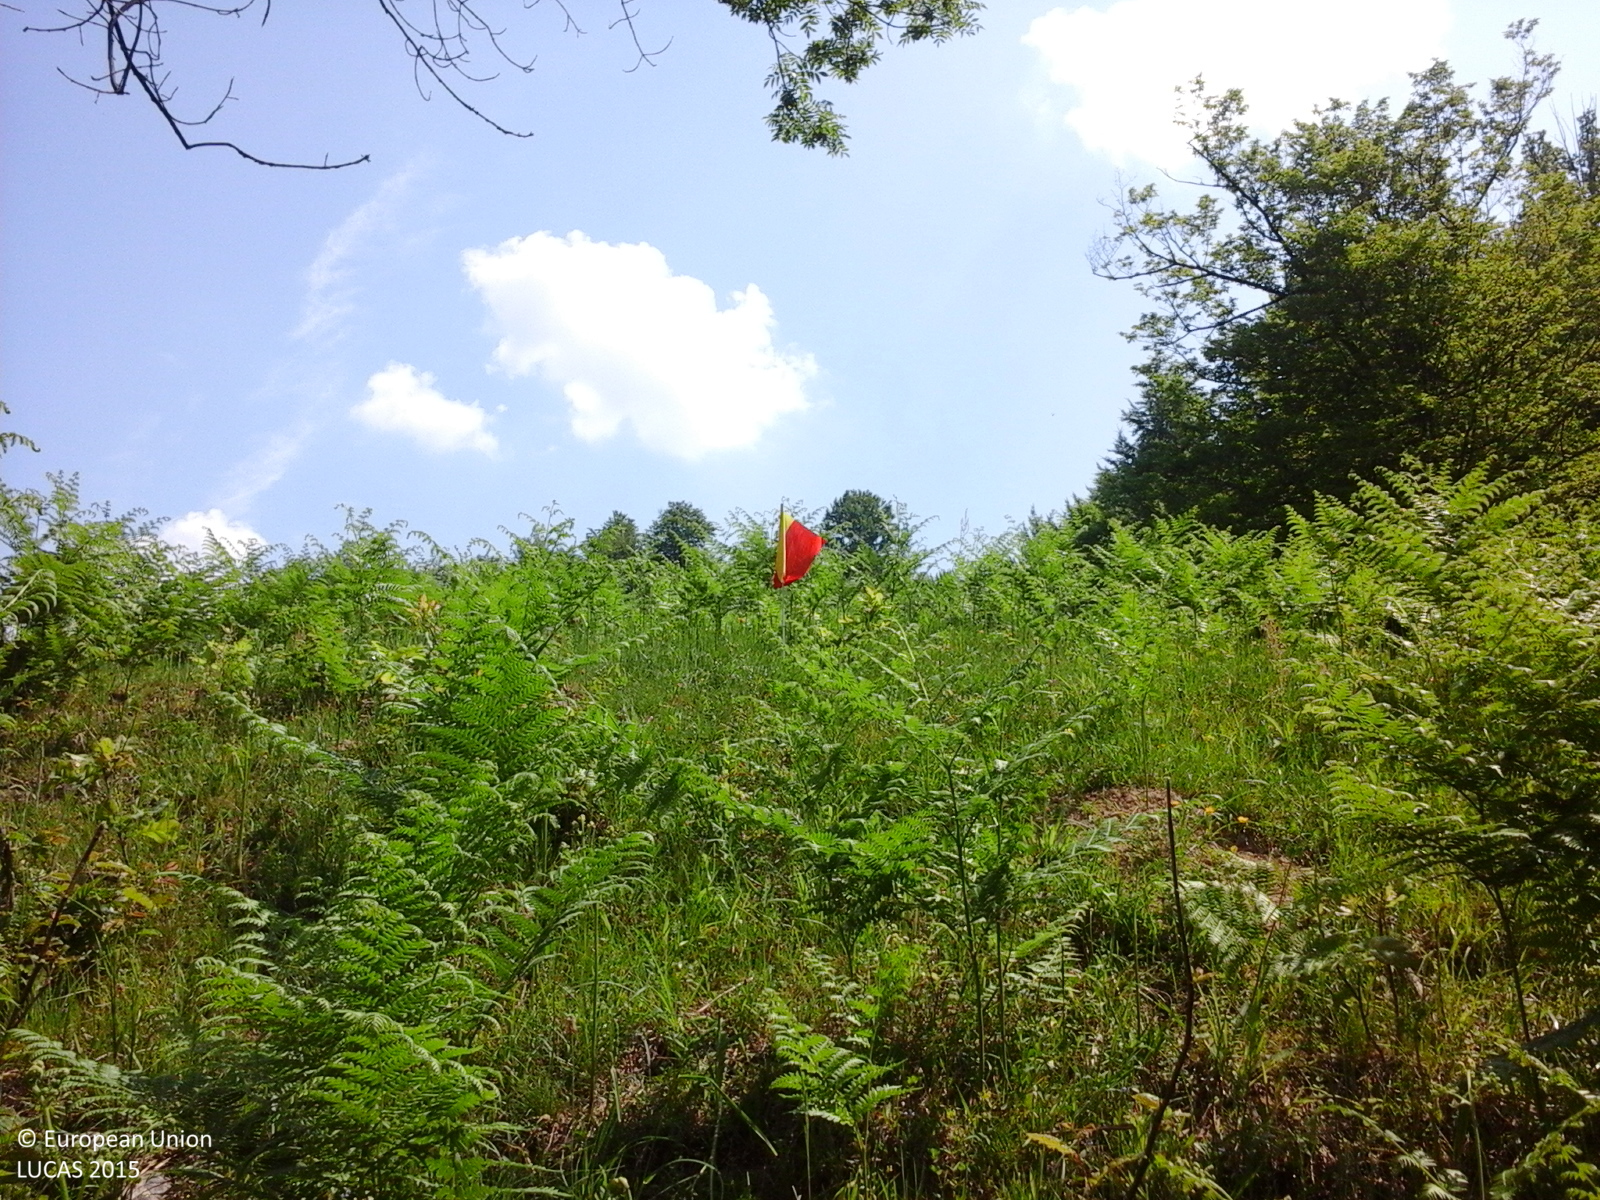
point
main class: Grassland
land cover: Grassland with sparse tree/shrub cover
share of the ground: > 75 %
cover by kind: herbaceous plants 95 %, broadleaved forest trees 5 %
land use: Agriculture (excluding fallow land and kitchen gardens)
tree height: > 5 m
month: June
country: RO
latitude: 46.3360
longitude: 26.4351
